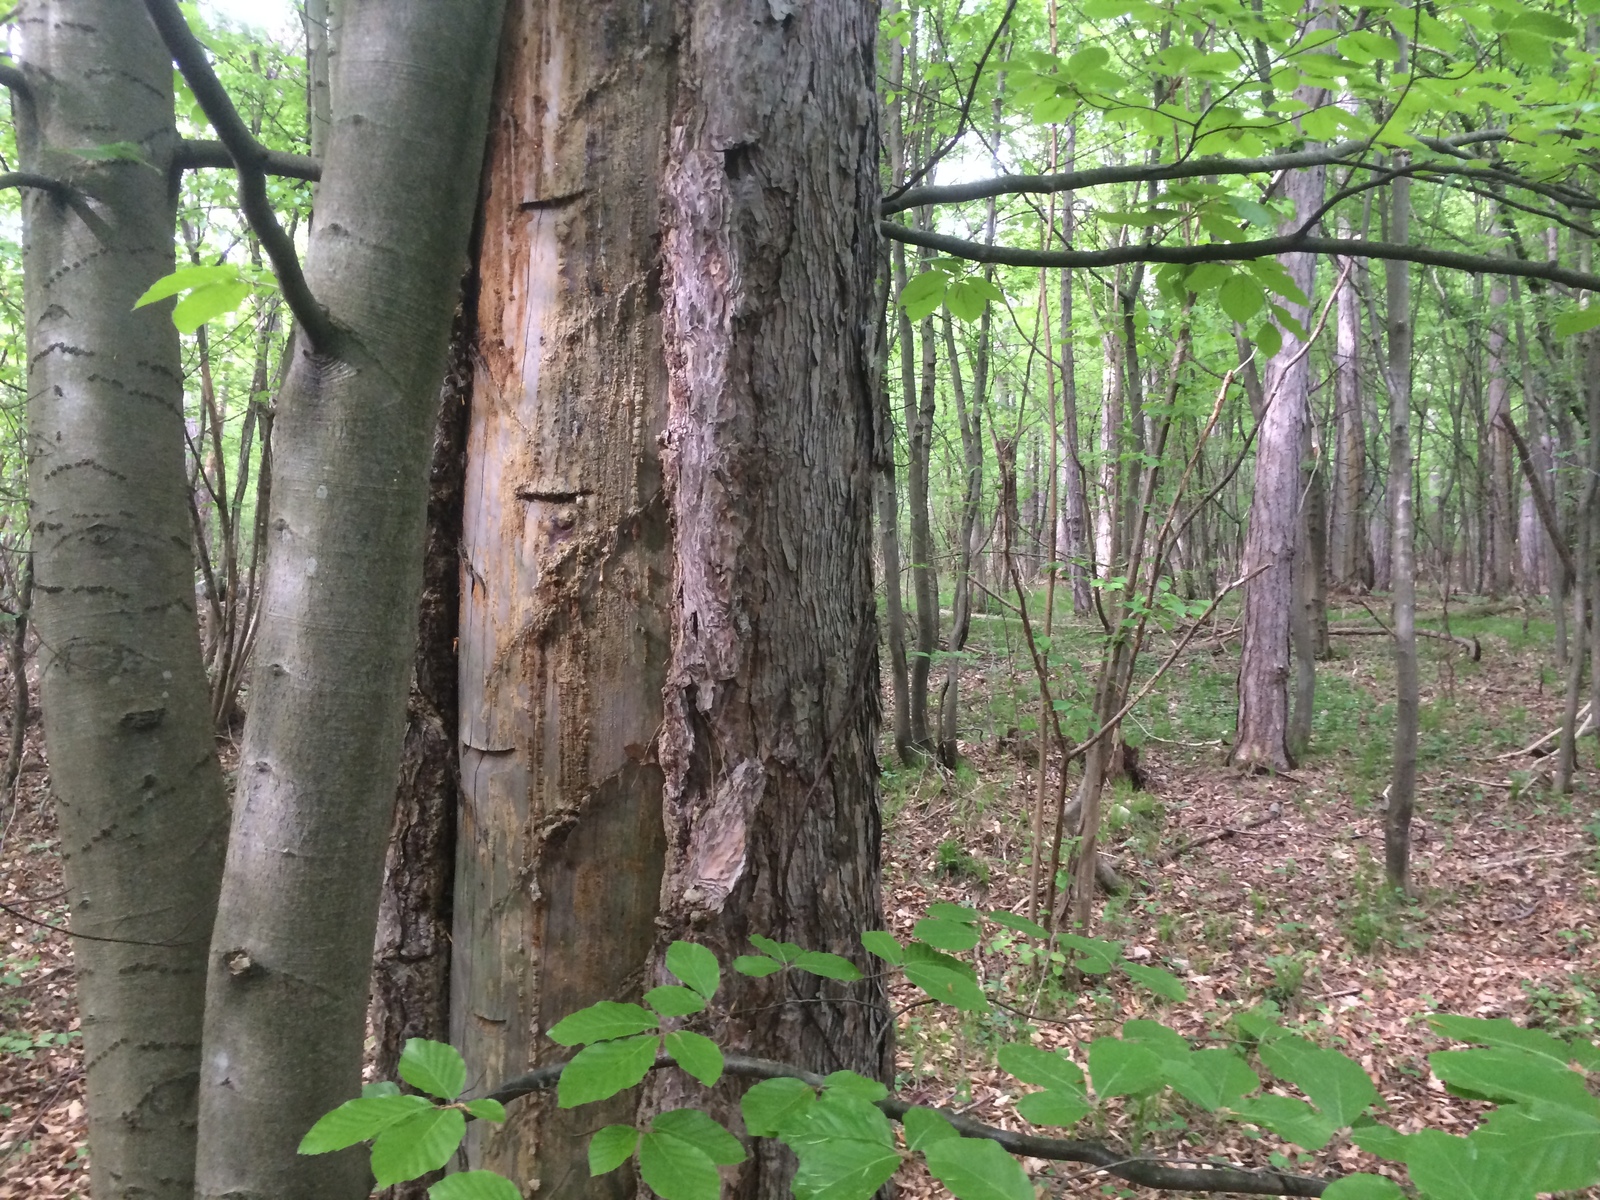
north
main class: Woodland
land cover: Pine dominated mixed woodland
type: hemiboreal forest and nemoral coniferous forest and mixed broadleaved-coniferous forest
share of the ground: > 75 %
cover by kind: coniferous forest trees 50 %, broadleaved forest trees 50 %
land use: Forestry
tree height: > 5 m
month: May
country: AT
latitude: 47.9272
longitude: 16.1199
